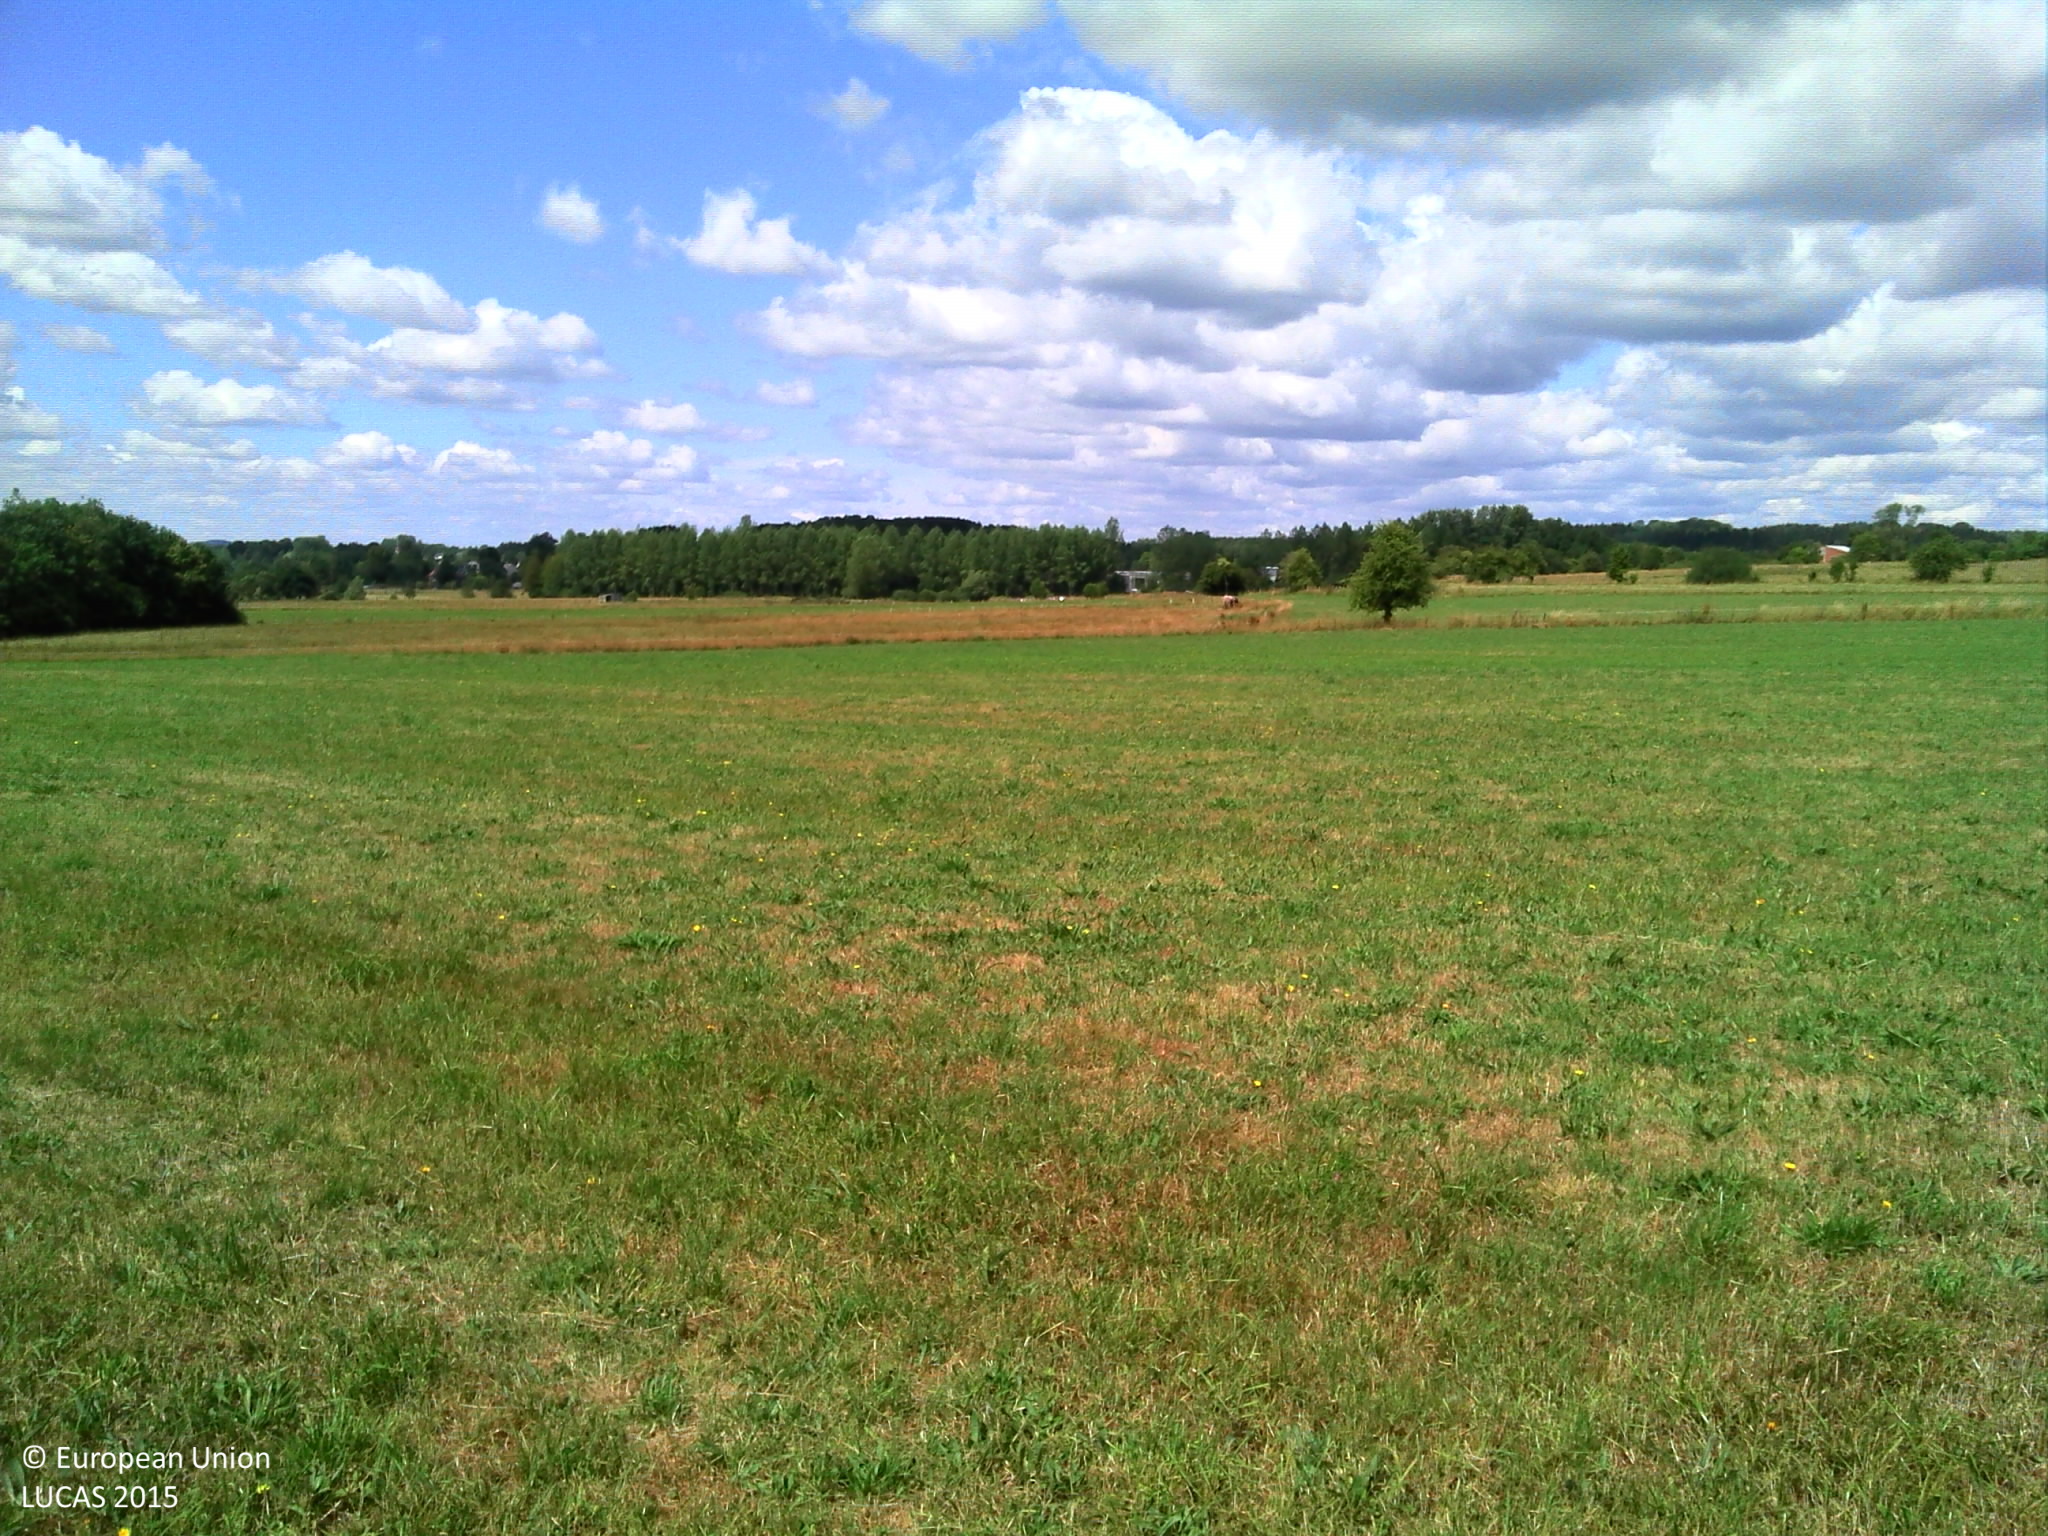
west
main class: Grassland
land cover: Grassland without tree/shrub cover
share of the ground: > 75 %
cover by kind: herbaceous plants 100 %
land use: Agriculture (excluding fallow land and kitchen gardens)
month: July
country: BE
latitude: 49.7191
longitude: 5.5462
